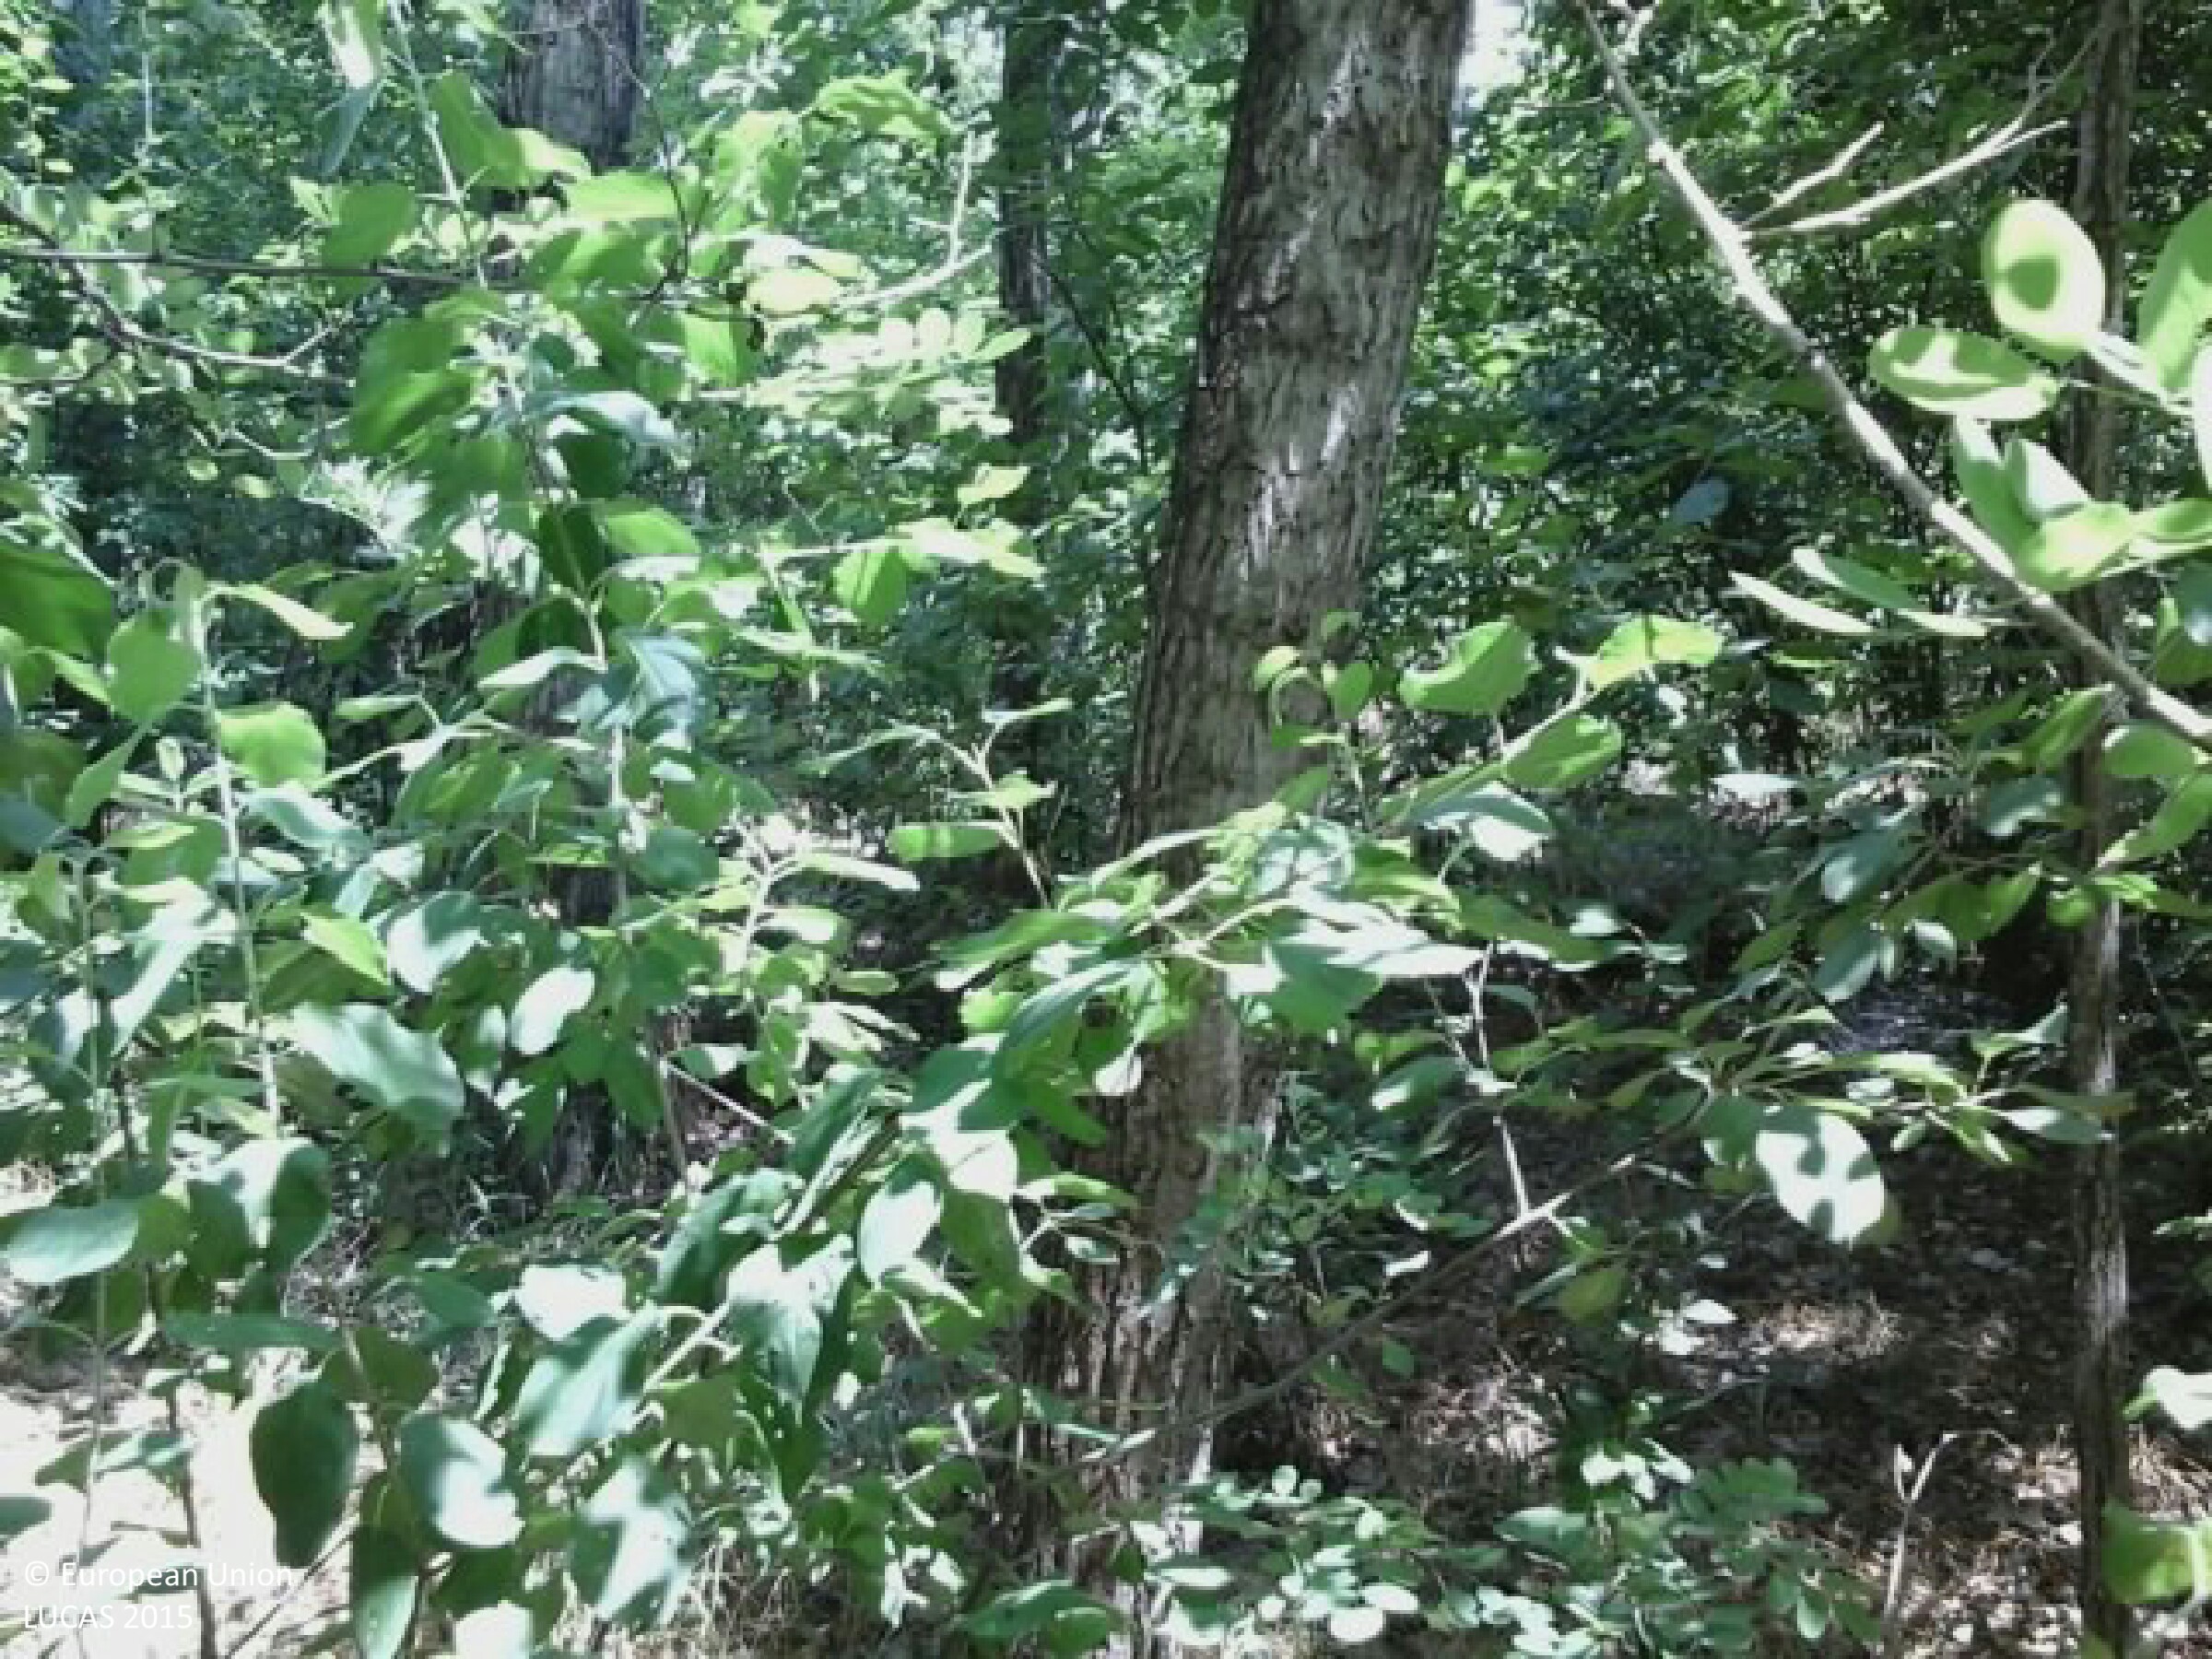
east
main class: Woodland
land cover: Broadleaved woodland
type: mesophytic deciduous forest
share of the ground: > 75 %
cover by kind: broadleaved forest trees 80 %, shrubs 20 %
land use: Forestry
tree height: < 5 m
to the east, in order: Broadleaved woodland; Shrubland without tree cover; Grassland with sparse tree/shrub cover; Electric lines; Grassland with sparse tree/shrub cover; Artificial constructions in urban areas
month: June
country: HU
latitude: 46.1179
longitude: 18.9793
